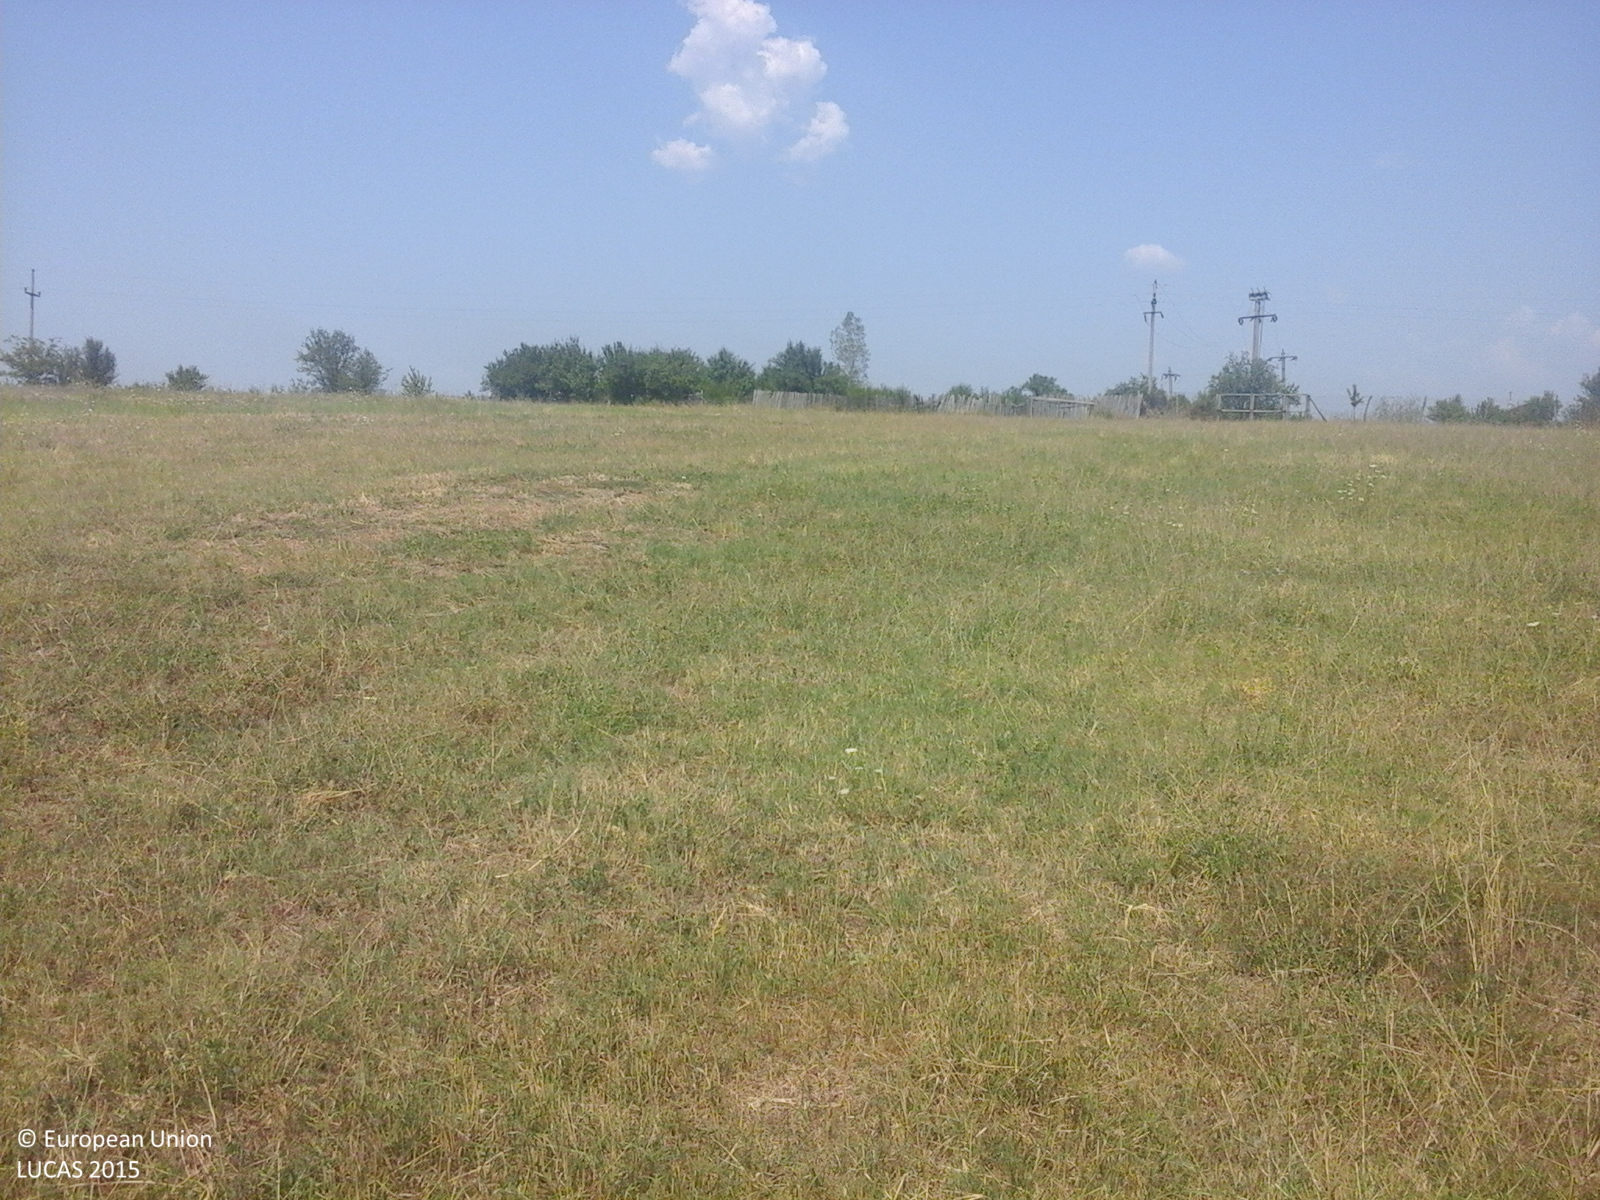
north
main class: Grassland
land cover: Grassland without tree/shrub cover
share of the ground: > 75 %
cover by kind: herbaceous plants 100 %
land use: Agriculture (excluding fallow land and kitchen gardens)
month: August
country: RO
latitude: 44.5112
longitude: 23.1684
